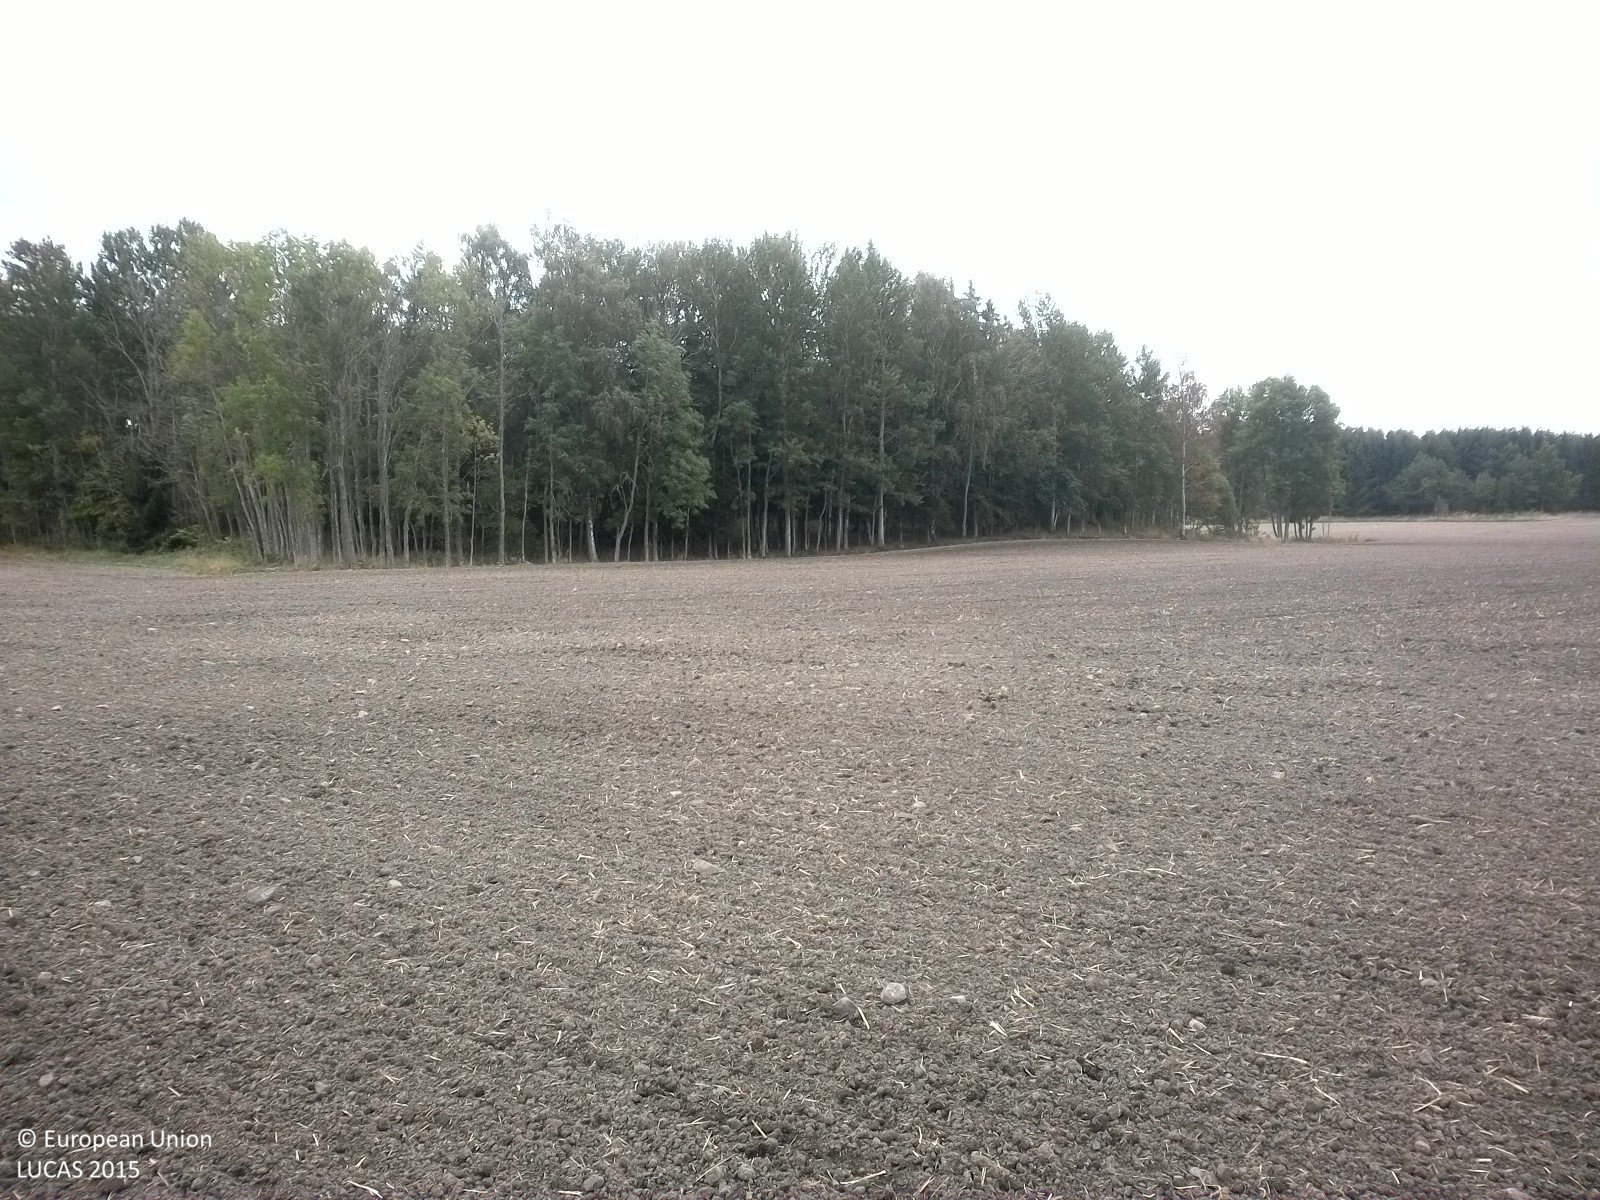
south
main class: Cropland
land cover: Common wheat
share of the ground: < 10 %
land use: Agriculture (excluding fallow land and kitchen gardens)
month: September
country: SE
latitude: 58.5574
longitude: 16.3376
